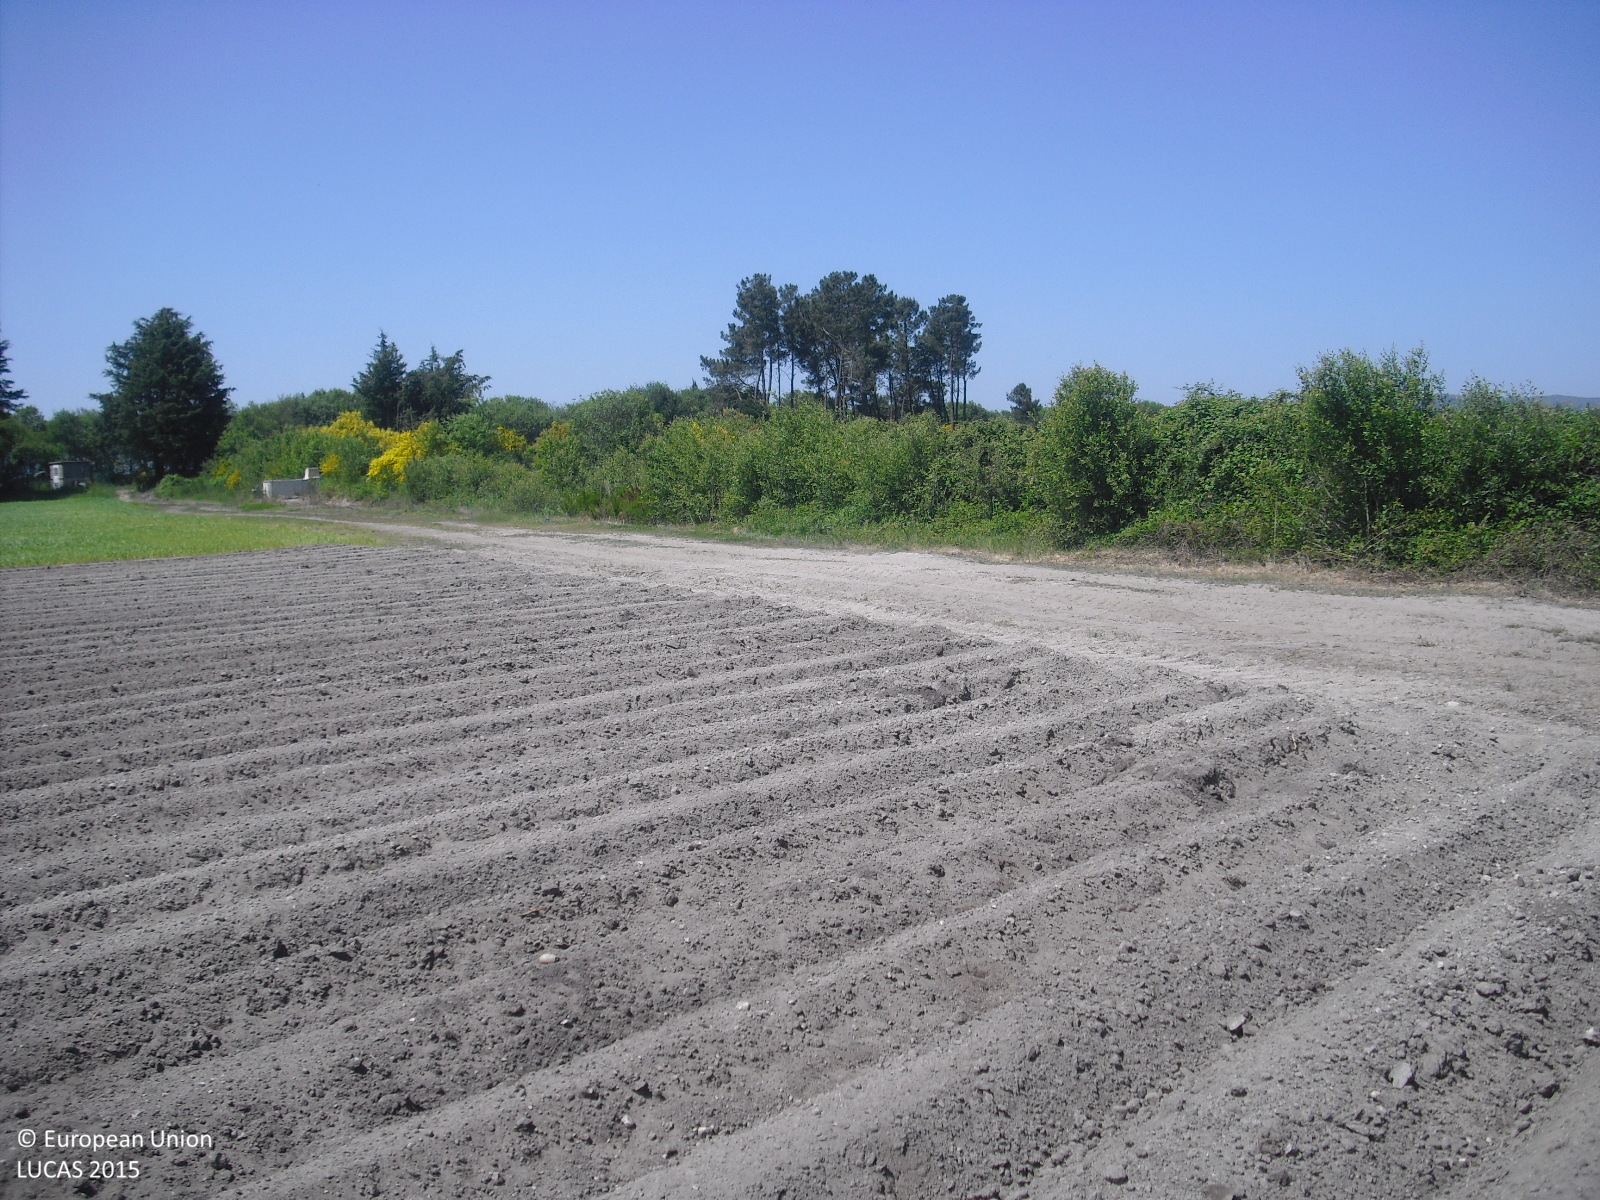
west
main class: Cropland
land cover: Potatoes
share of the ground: < 10 %
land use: Agriculture (excluding fallow land and kitchen gardens)
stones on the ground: < 10 %
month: May
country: ES
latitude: 42.1150
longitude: -7.6910
